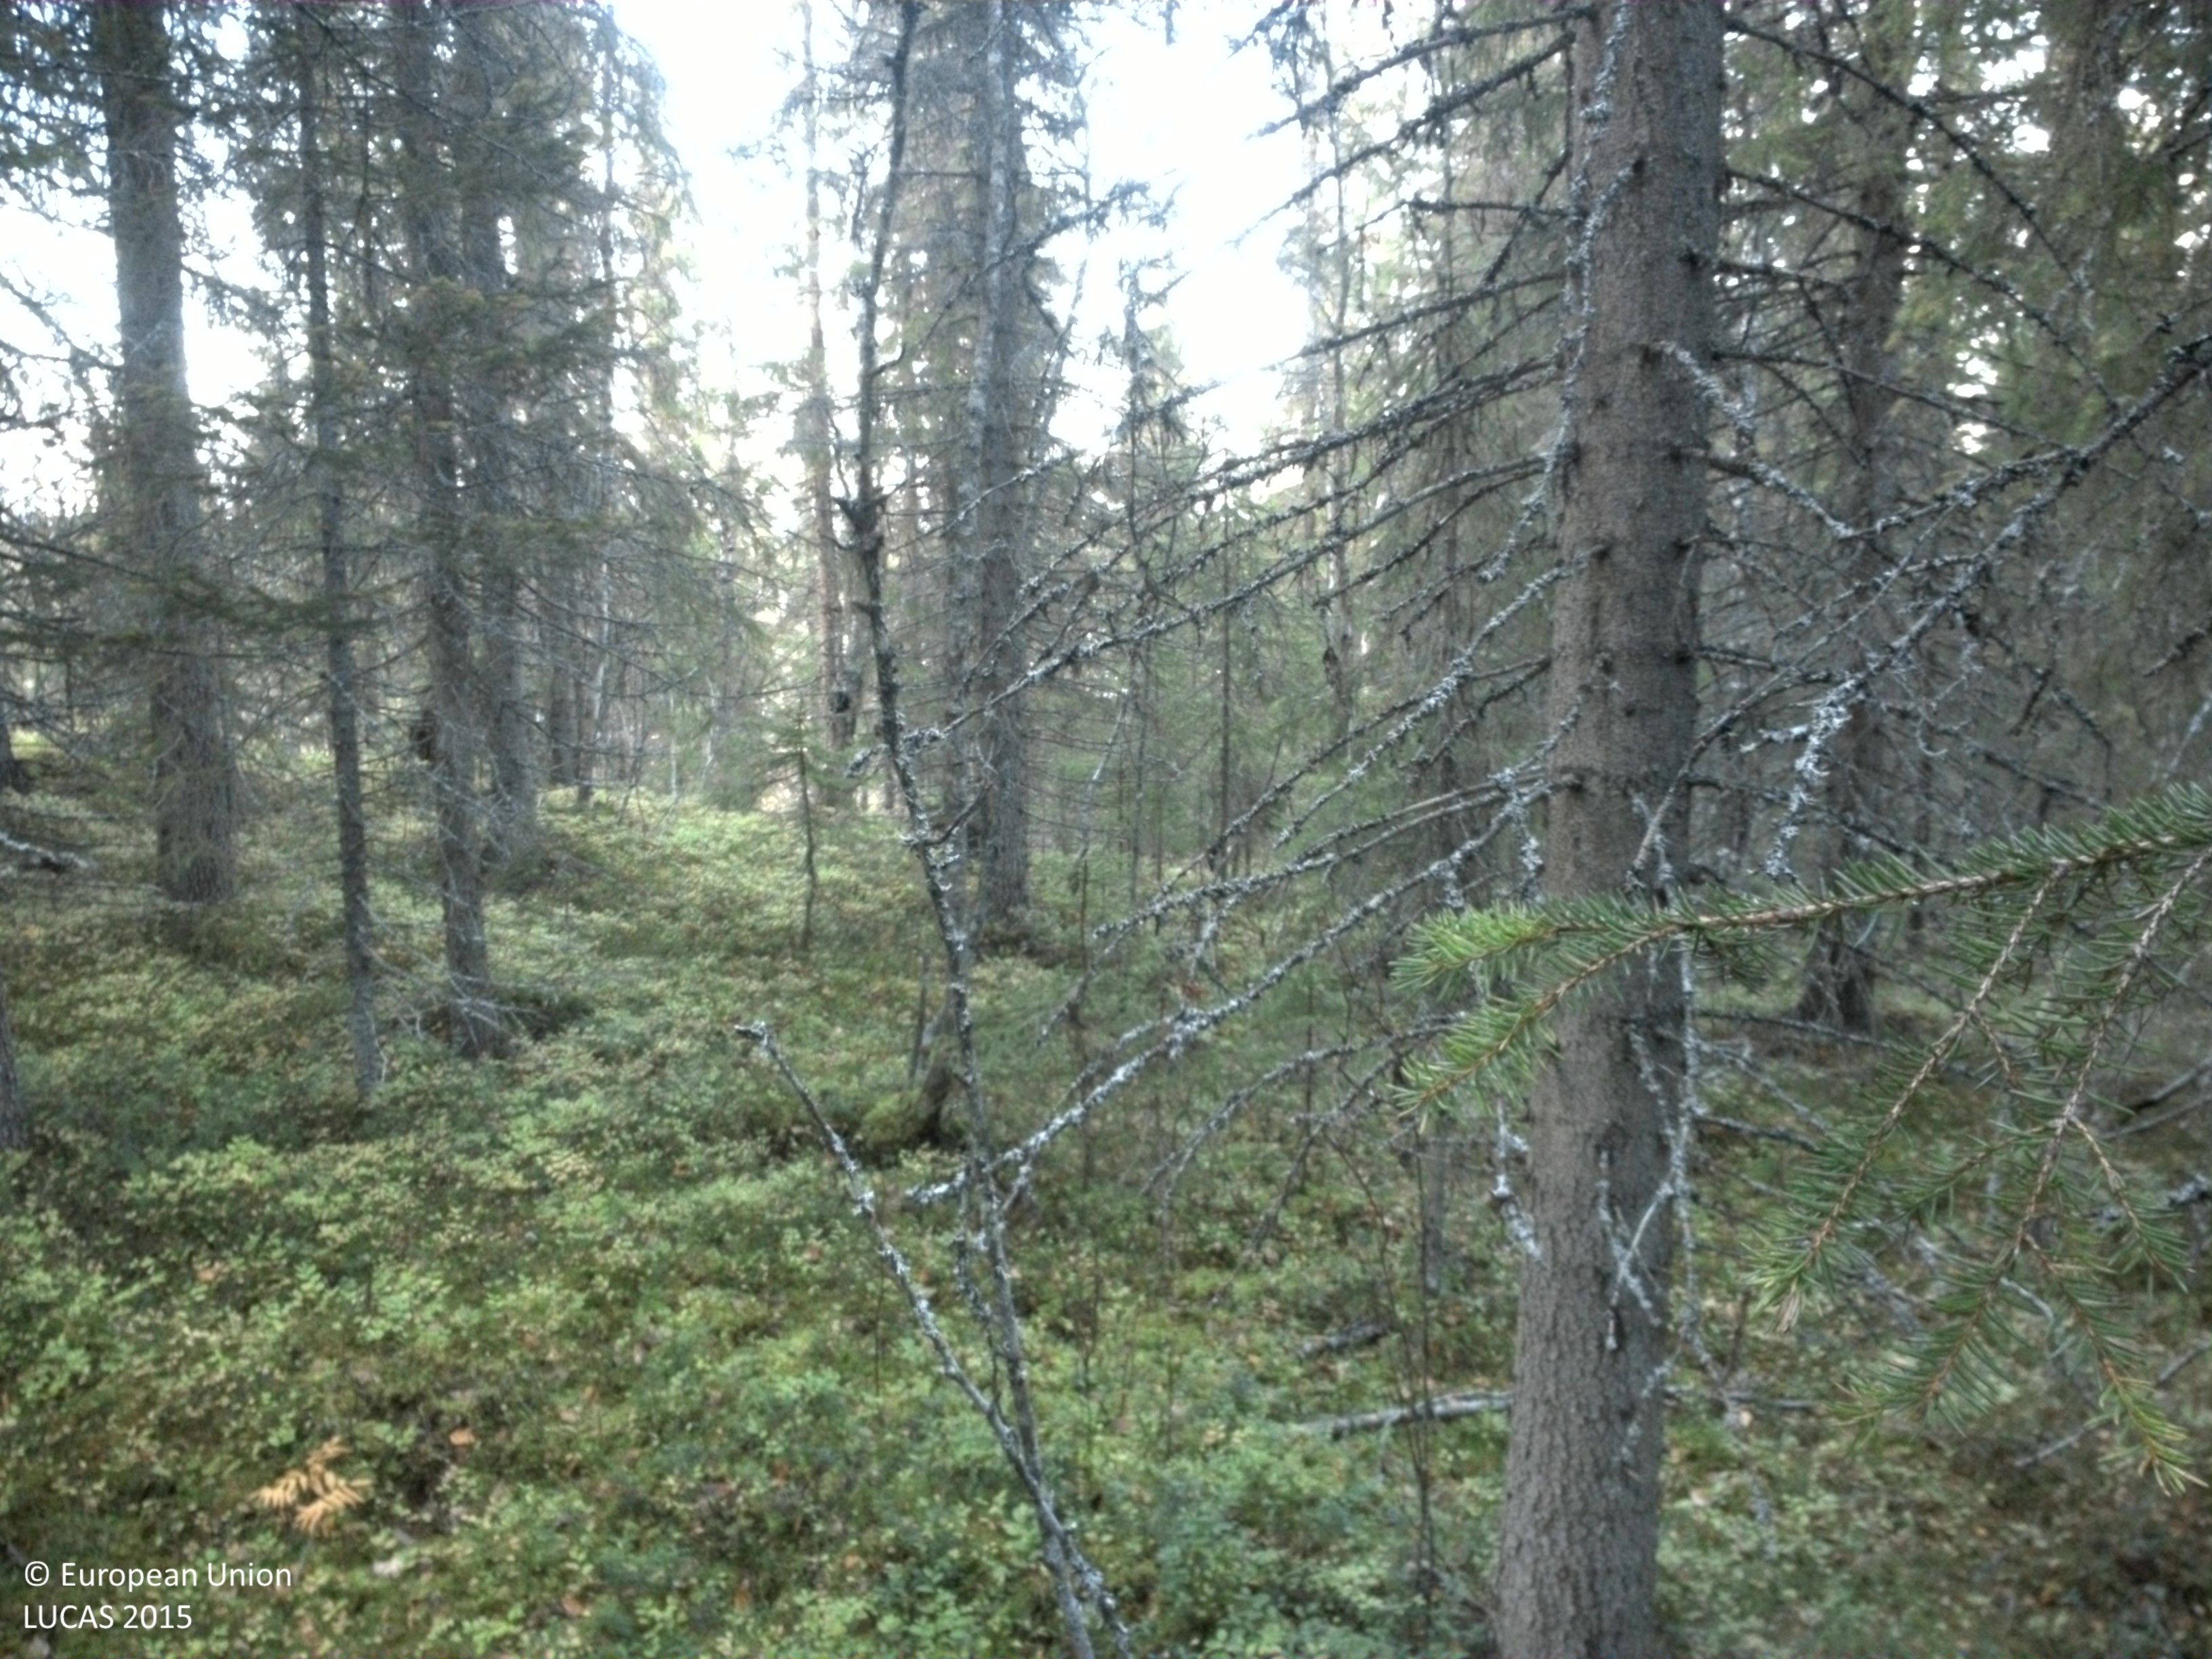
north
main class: Woodland
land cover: Spruce dominated coniferous woodland
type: boreal forest
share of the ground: 50 - 75 %
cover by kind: coniferous forest trees 45 %, shrubs 25 %, lichens and mosses 20 %, broadleaved forest trees 10 %
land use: Forestry
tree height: > 5 m
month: October
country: SE
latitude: 64.8026
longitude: 17.4804
